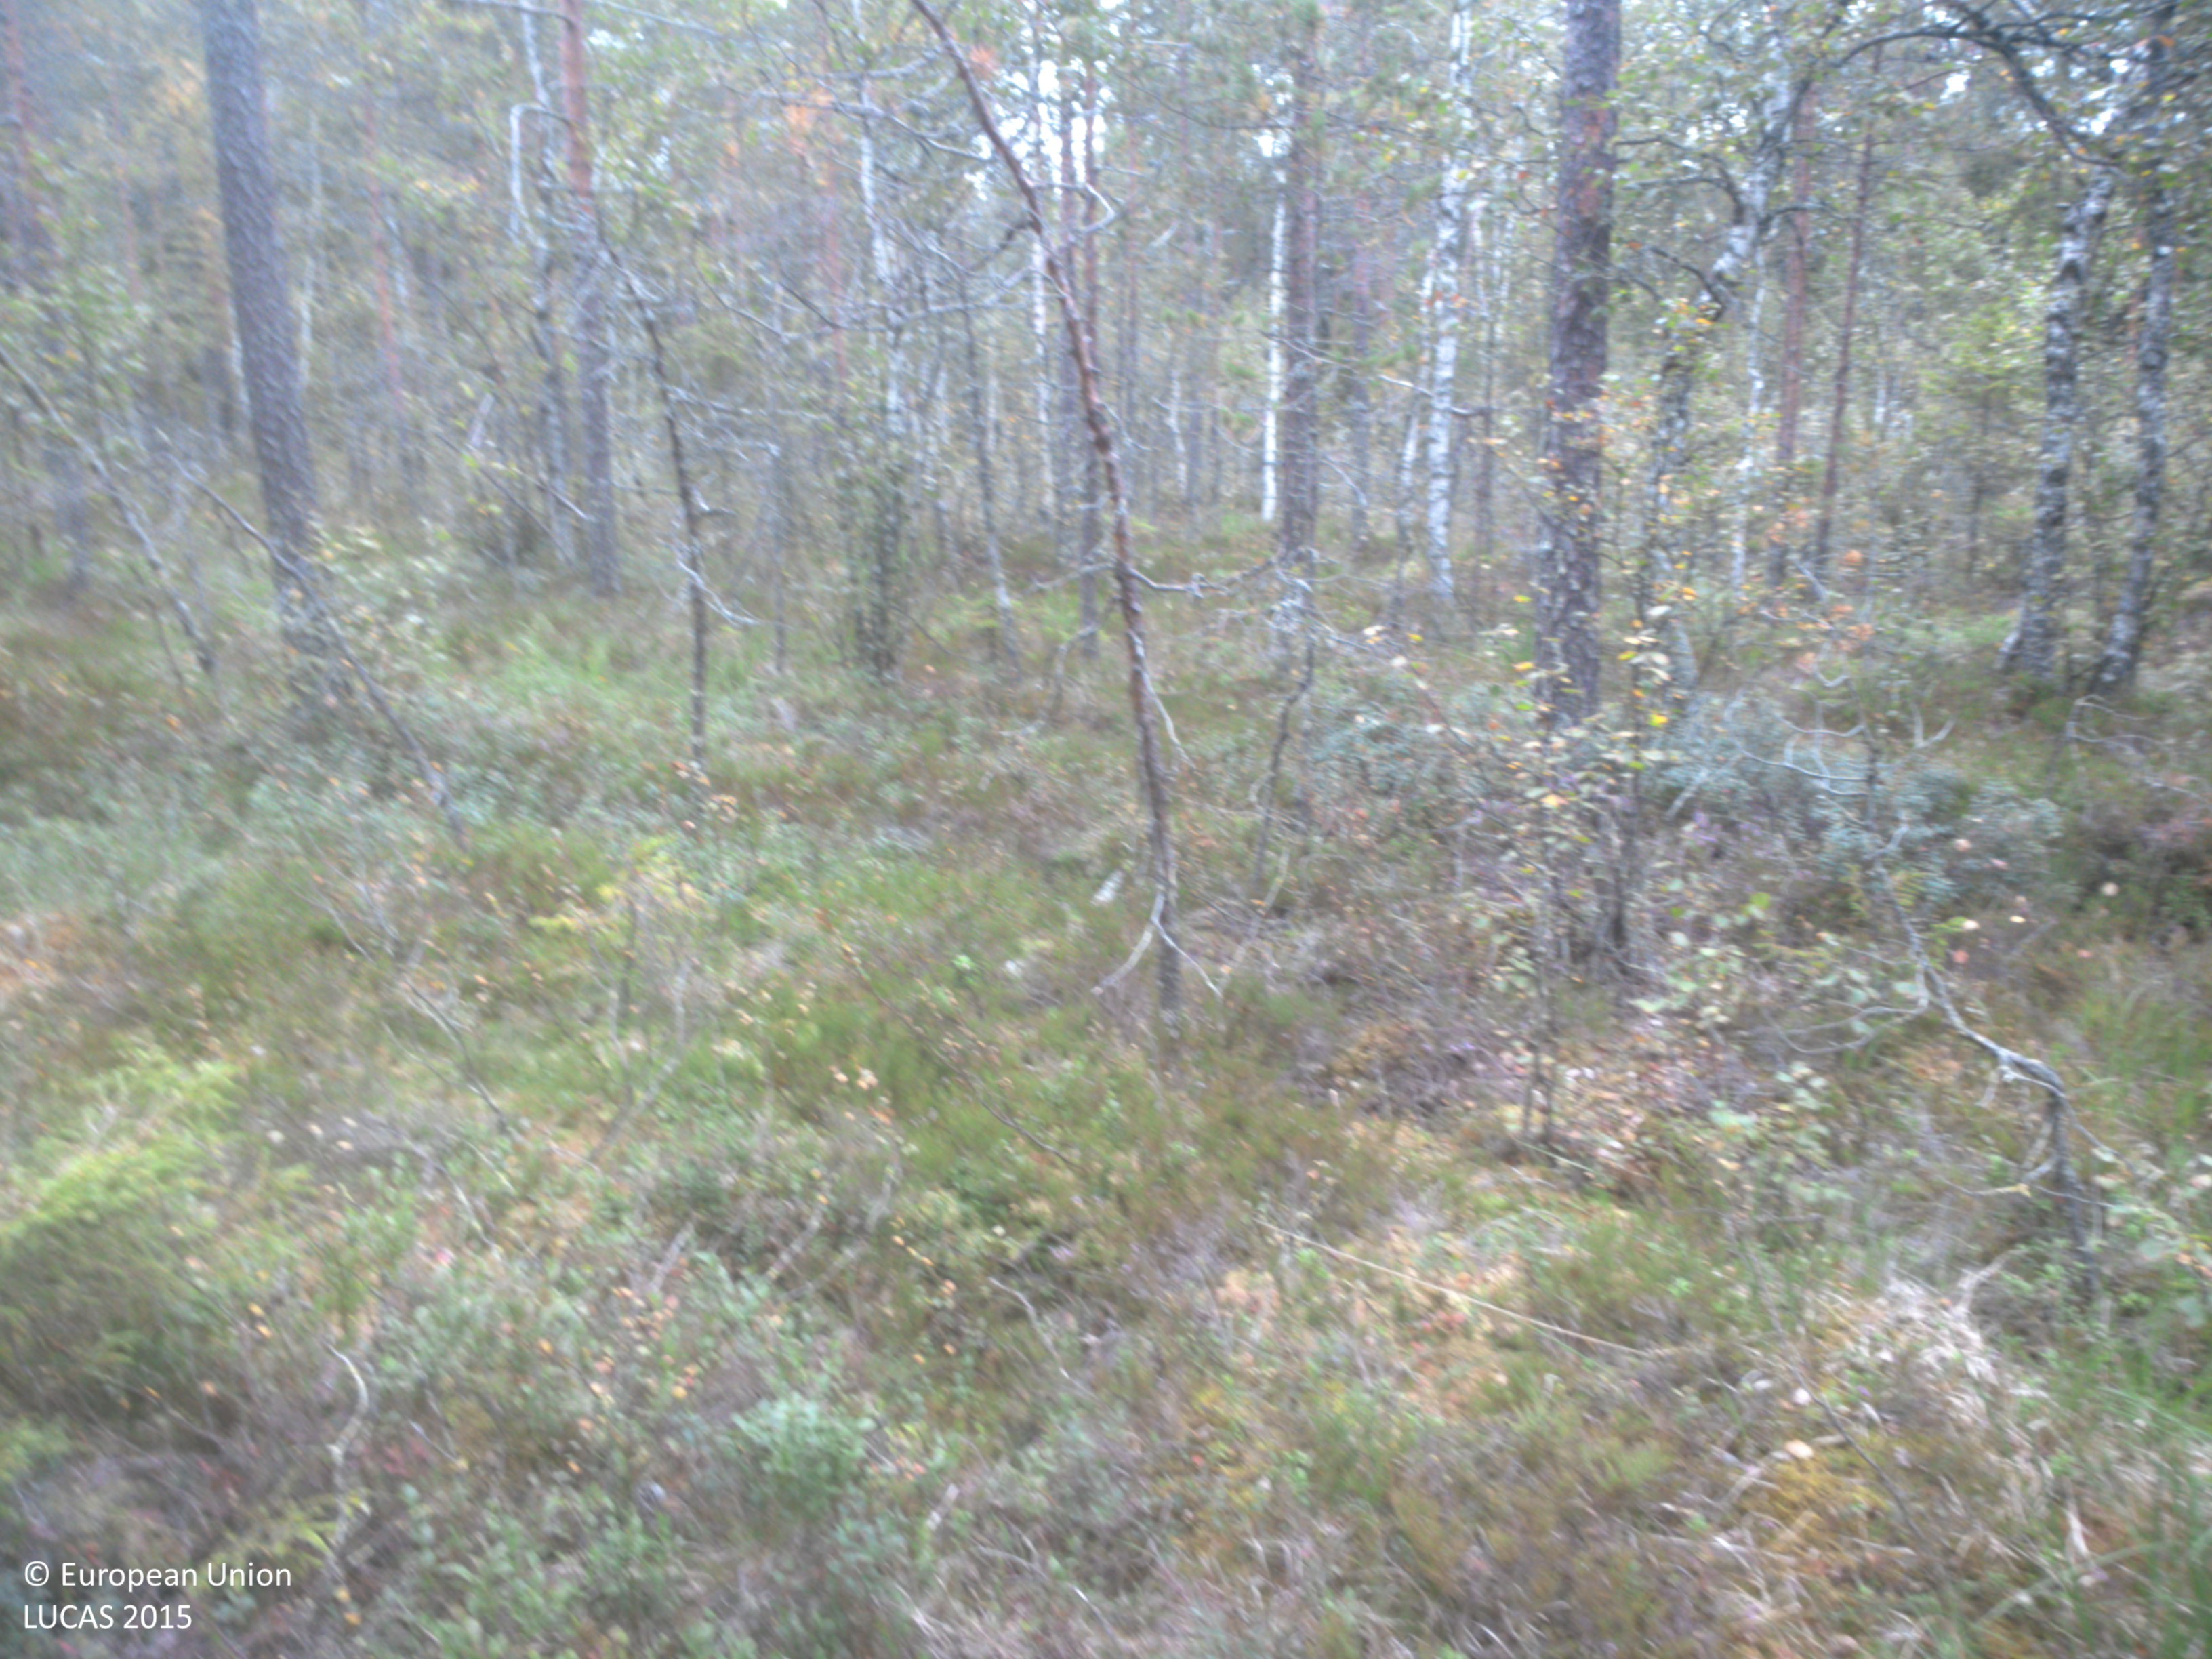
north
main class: Woodland
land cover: Pine dominated mixed woodland
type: boreal forest
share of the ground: 50 - 75 %
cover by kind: coniferous forest trees 40 %, shrubs 40 %, broadleaved forest trees 20 %
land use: Forestry
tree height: > 5 m
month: August
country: SE
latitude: 63.7352
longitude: 20.0069
